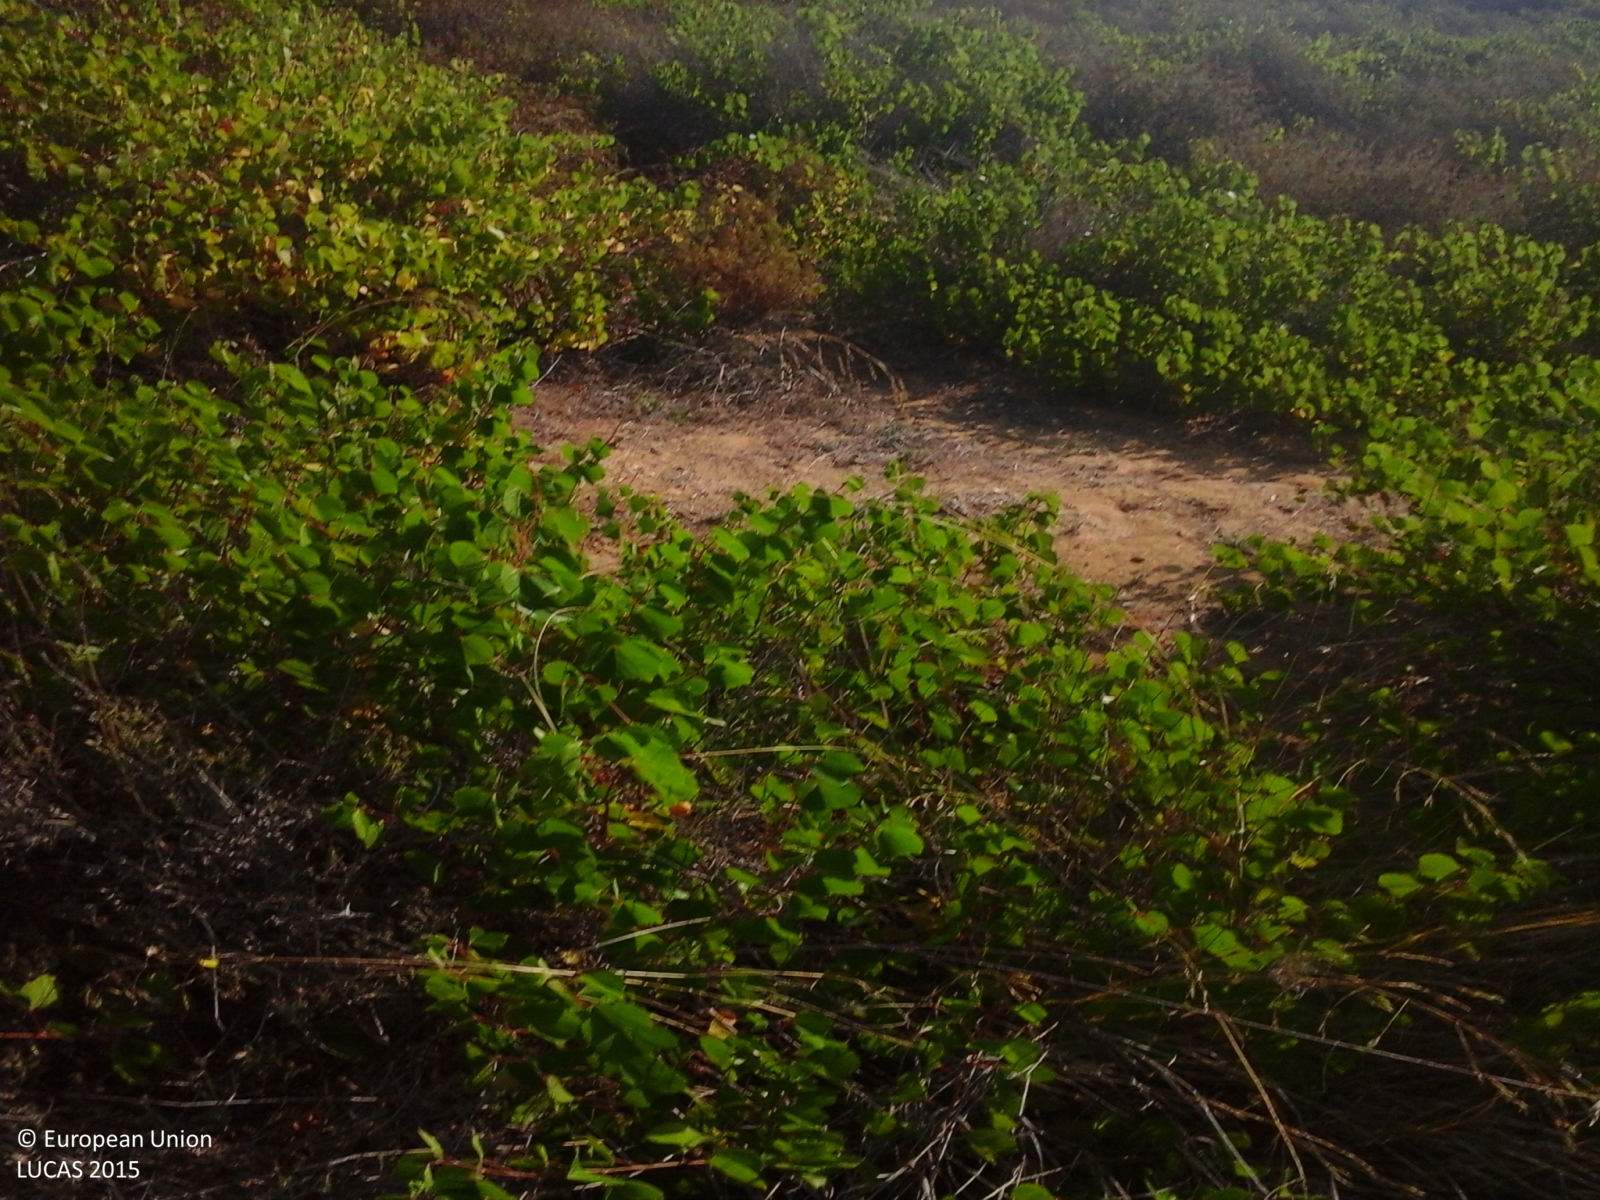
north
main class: Shrubland
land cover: Shrubland with sparse tree cover
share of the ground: > 75 %
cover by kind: shrubs 70 %, herbaceous plants 25 %, coniferous forest trees 5 %
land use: Semi-natural and natural areas not in use
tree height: < 5 m
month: July
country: IT
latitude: 37.0997
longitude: 14.4099
